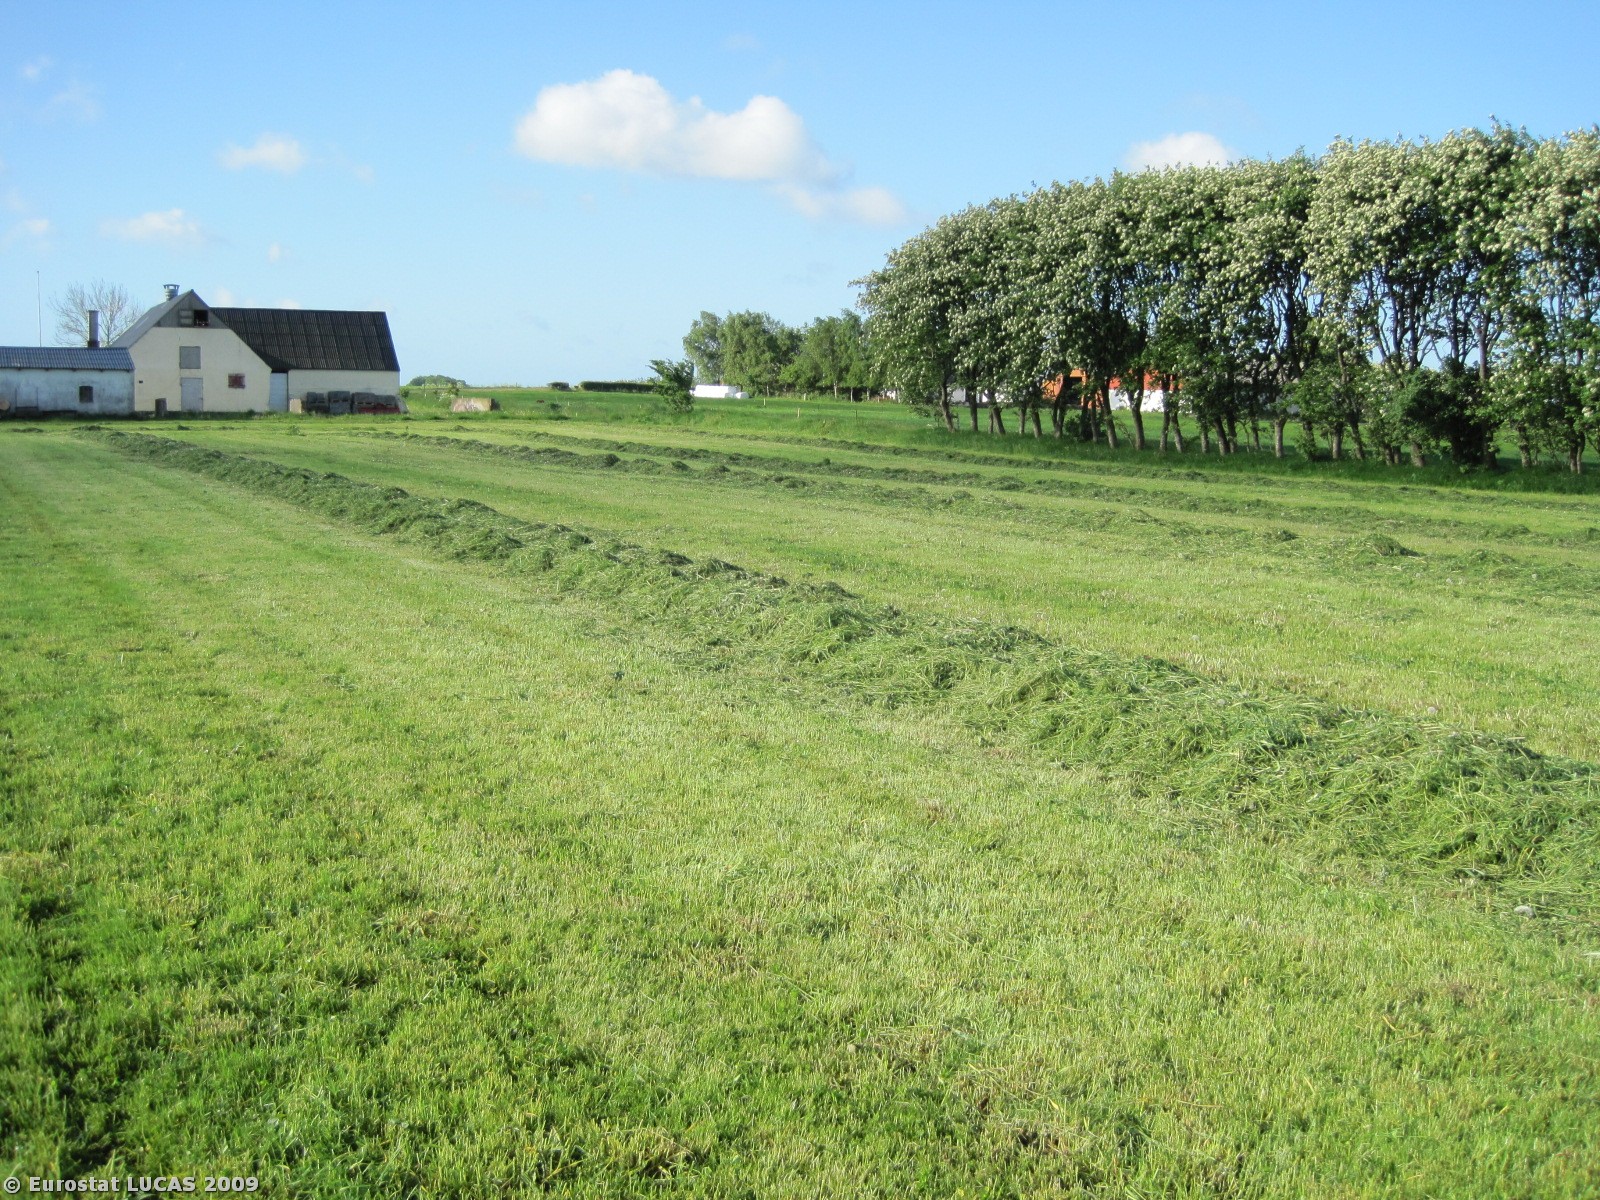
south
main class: Grassland
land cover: Grassland without tree/shrub cover
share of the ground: > 75 %
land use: Agriculture (excluding fallow land and kitchen gardens)
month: May
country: DK
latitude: 56.5111
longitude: 9.7566
